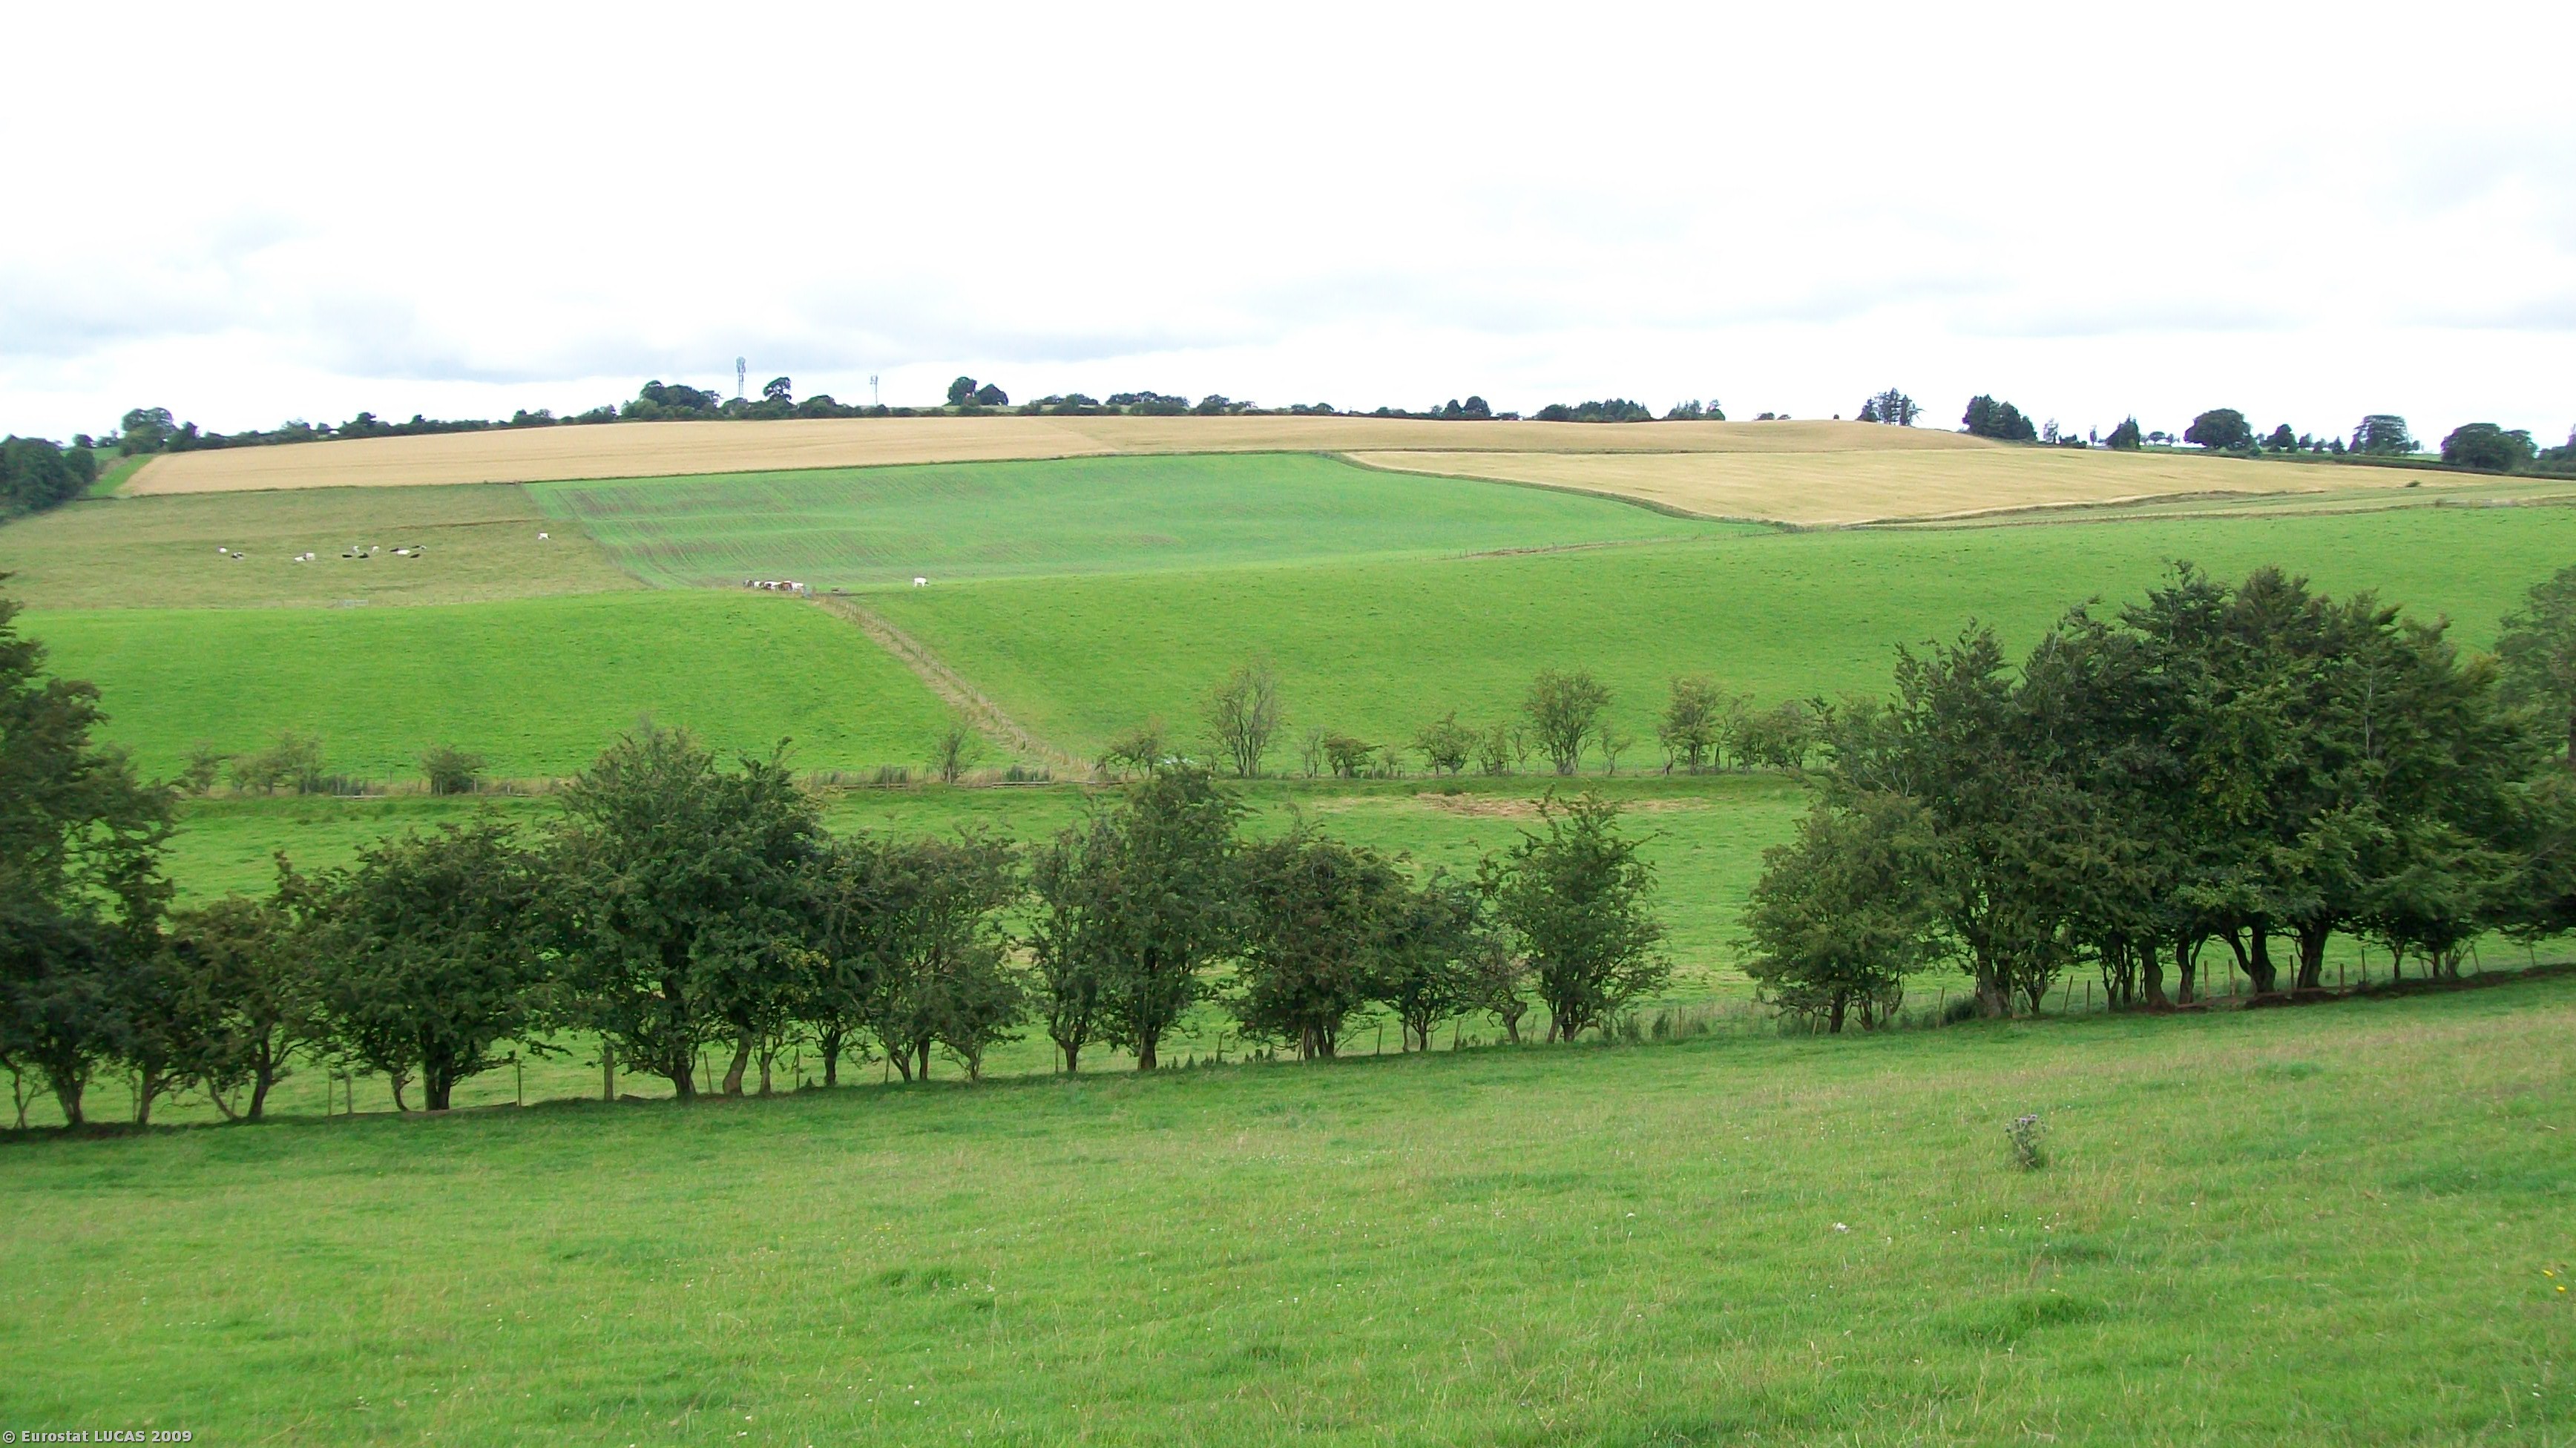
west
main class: Grassland
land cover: Grassland without tree/shrub cover
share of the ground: > 75 %
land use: Agriculture (excluding fallow land and kitchen gardens)
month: July
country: GB
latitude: 55.1234
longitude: -3.3276
